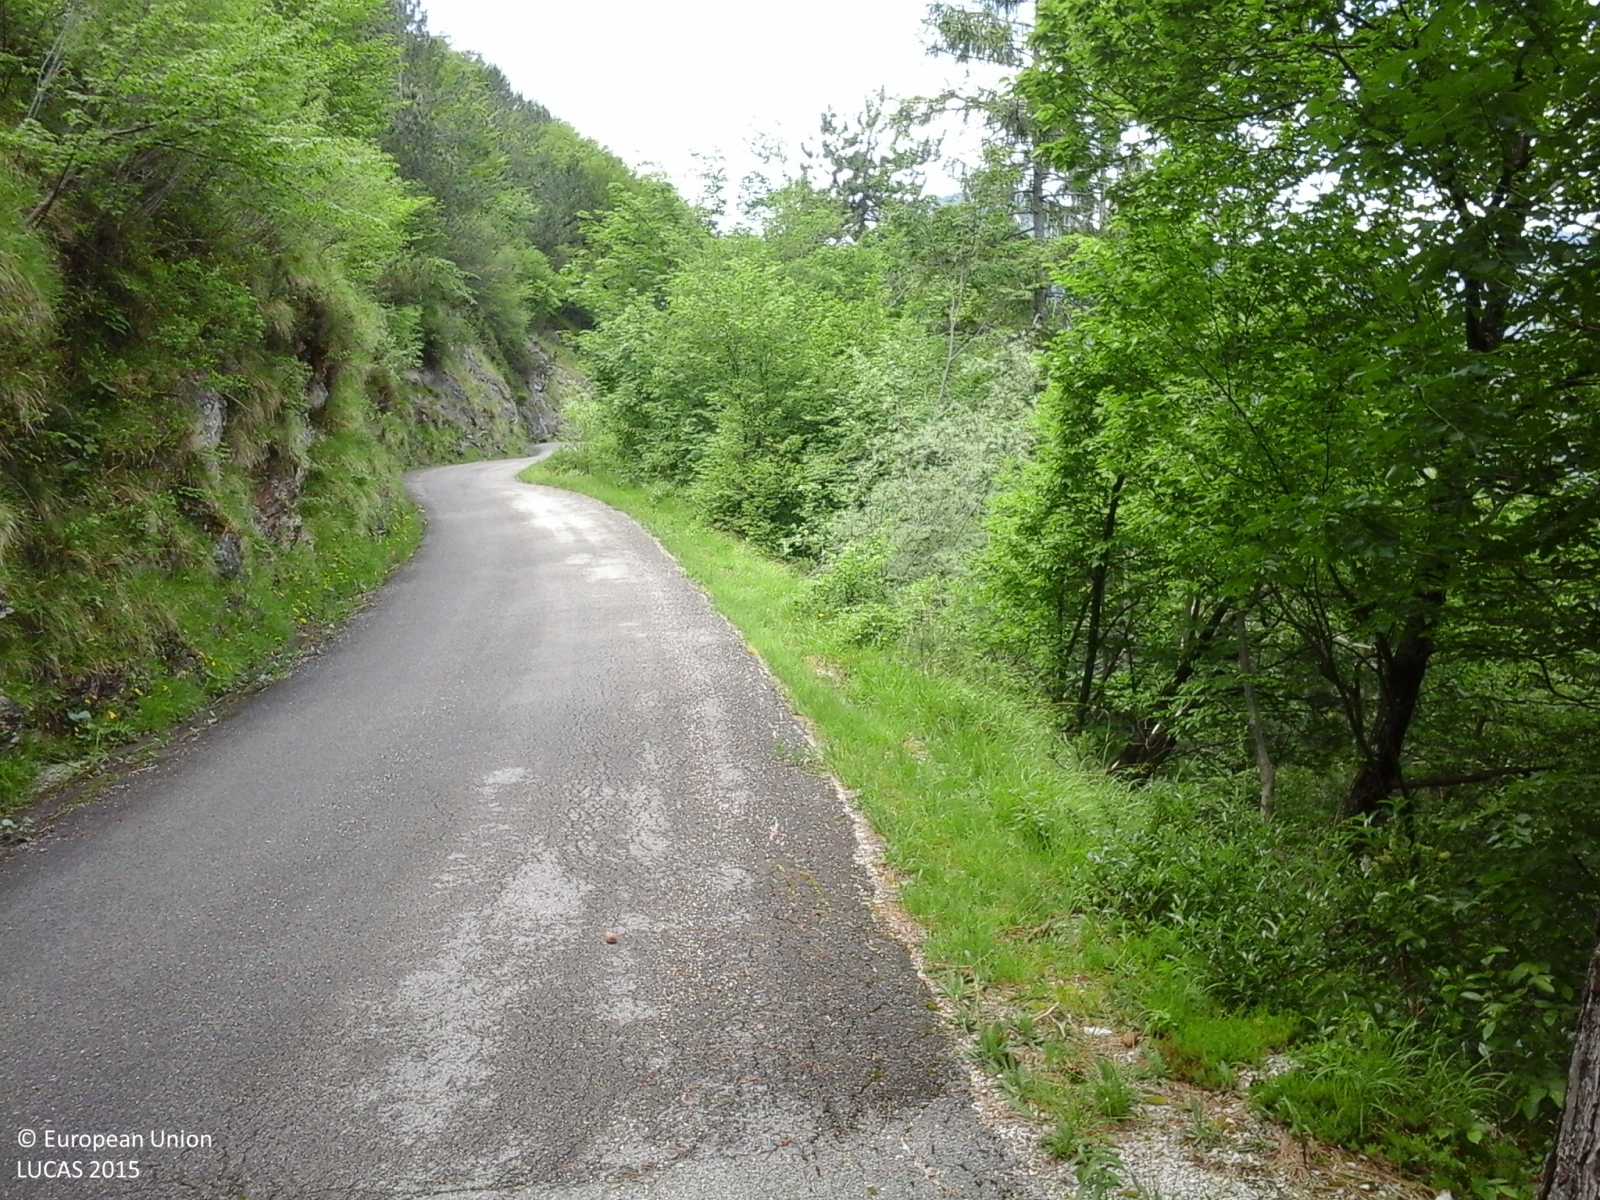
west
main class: Woodland
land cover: Other mixed woodland
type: mesophytic deciduous forest
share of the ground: > 75 %
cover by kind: broadleaved forest trees 60 %, coniferous forest trees 30 %, shrubs 10 %
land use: Semi-natural and natural areas not in use
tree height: > 5 m
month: June
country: IT
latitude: 46.2180
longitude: 12.3176
